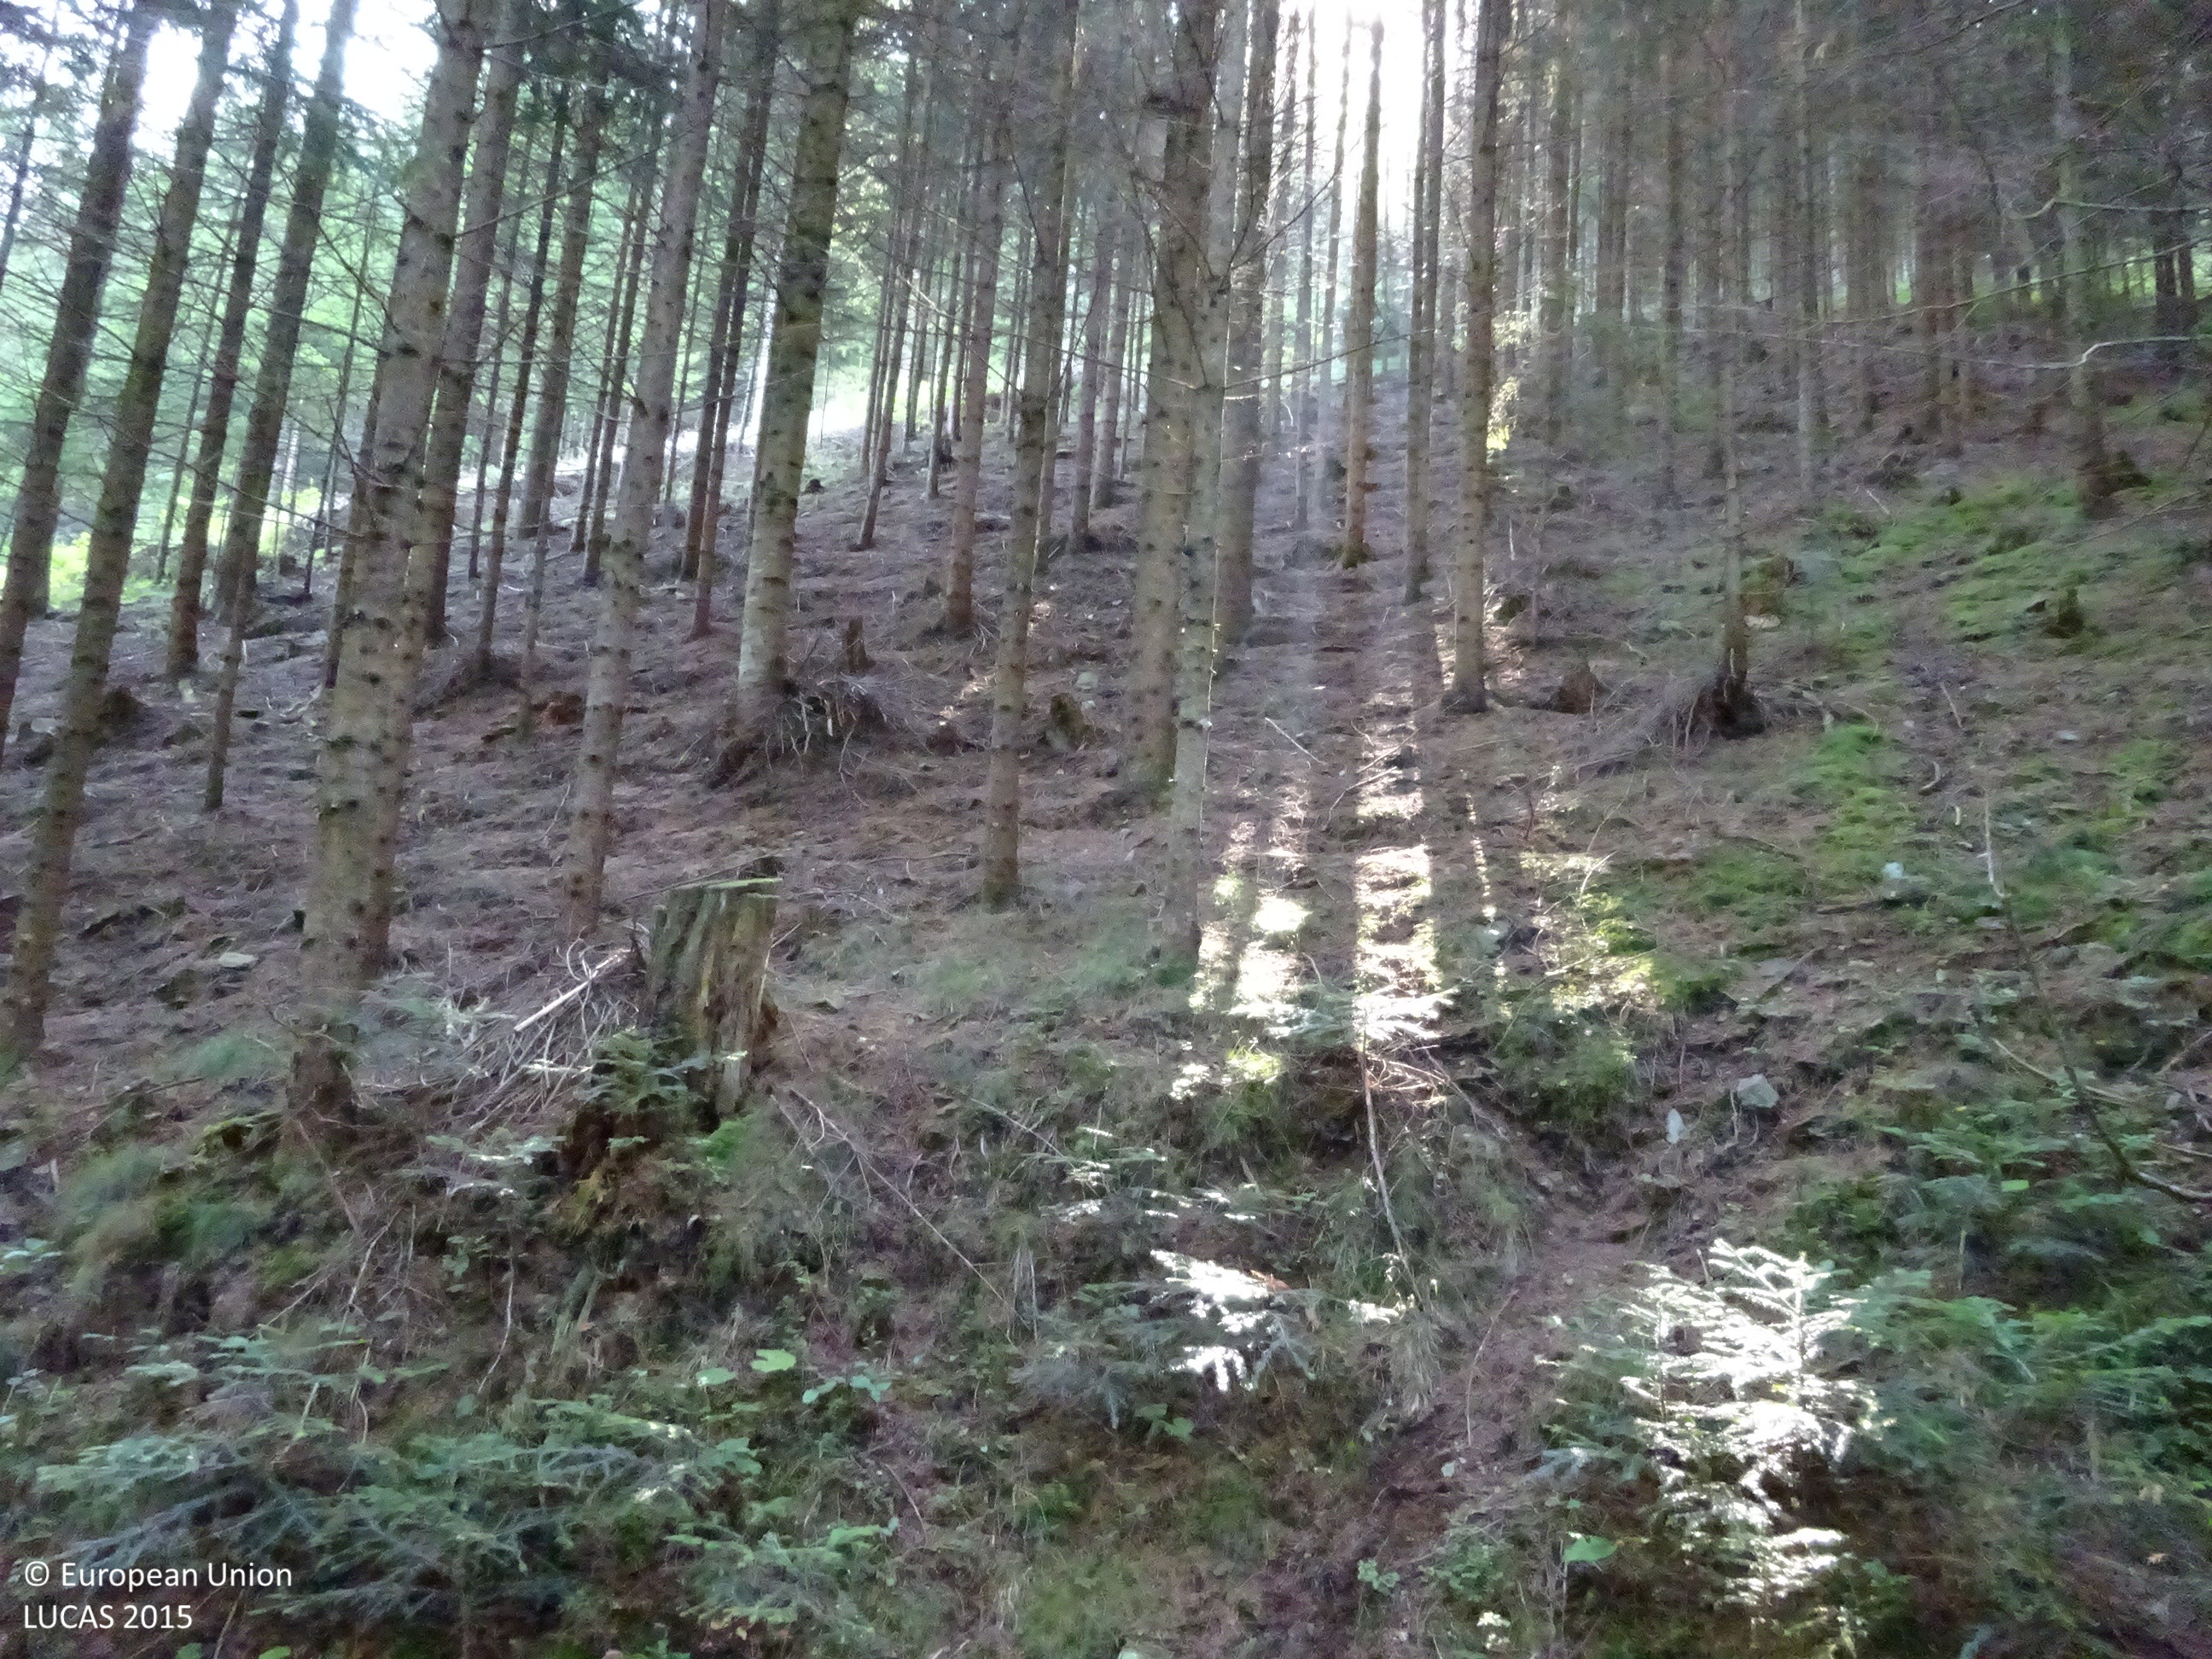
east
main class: Woodland
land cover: Spruce dominated coniferous woodland
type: alpine coniferous forest
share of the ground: > 75 %
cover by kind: coniferous forest trees 95 %, unconsolidated bare surface 5 %
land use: Forestry
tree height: > 5 m
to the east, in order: Spruce dominated coniferous woodland; Tracks; Spruce dominated coniferous woodland; Paved roads, cycling and walking lanes; Other coniferous woodland; Paved roads, cycling and walking lanes; Grassland with sparse tree/shrub cover; Other coniferous woodland; Tracks; Other coniferous woodland; Grassland without tree/shrub cover; Artificial constructions in urban areas
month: August
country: AT
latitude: 47.3899
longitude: 15.7109
